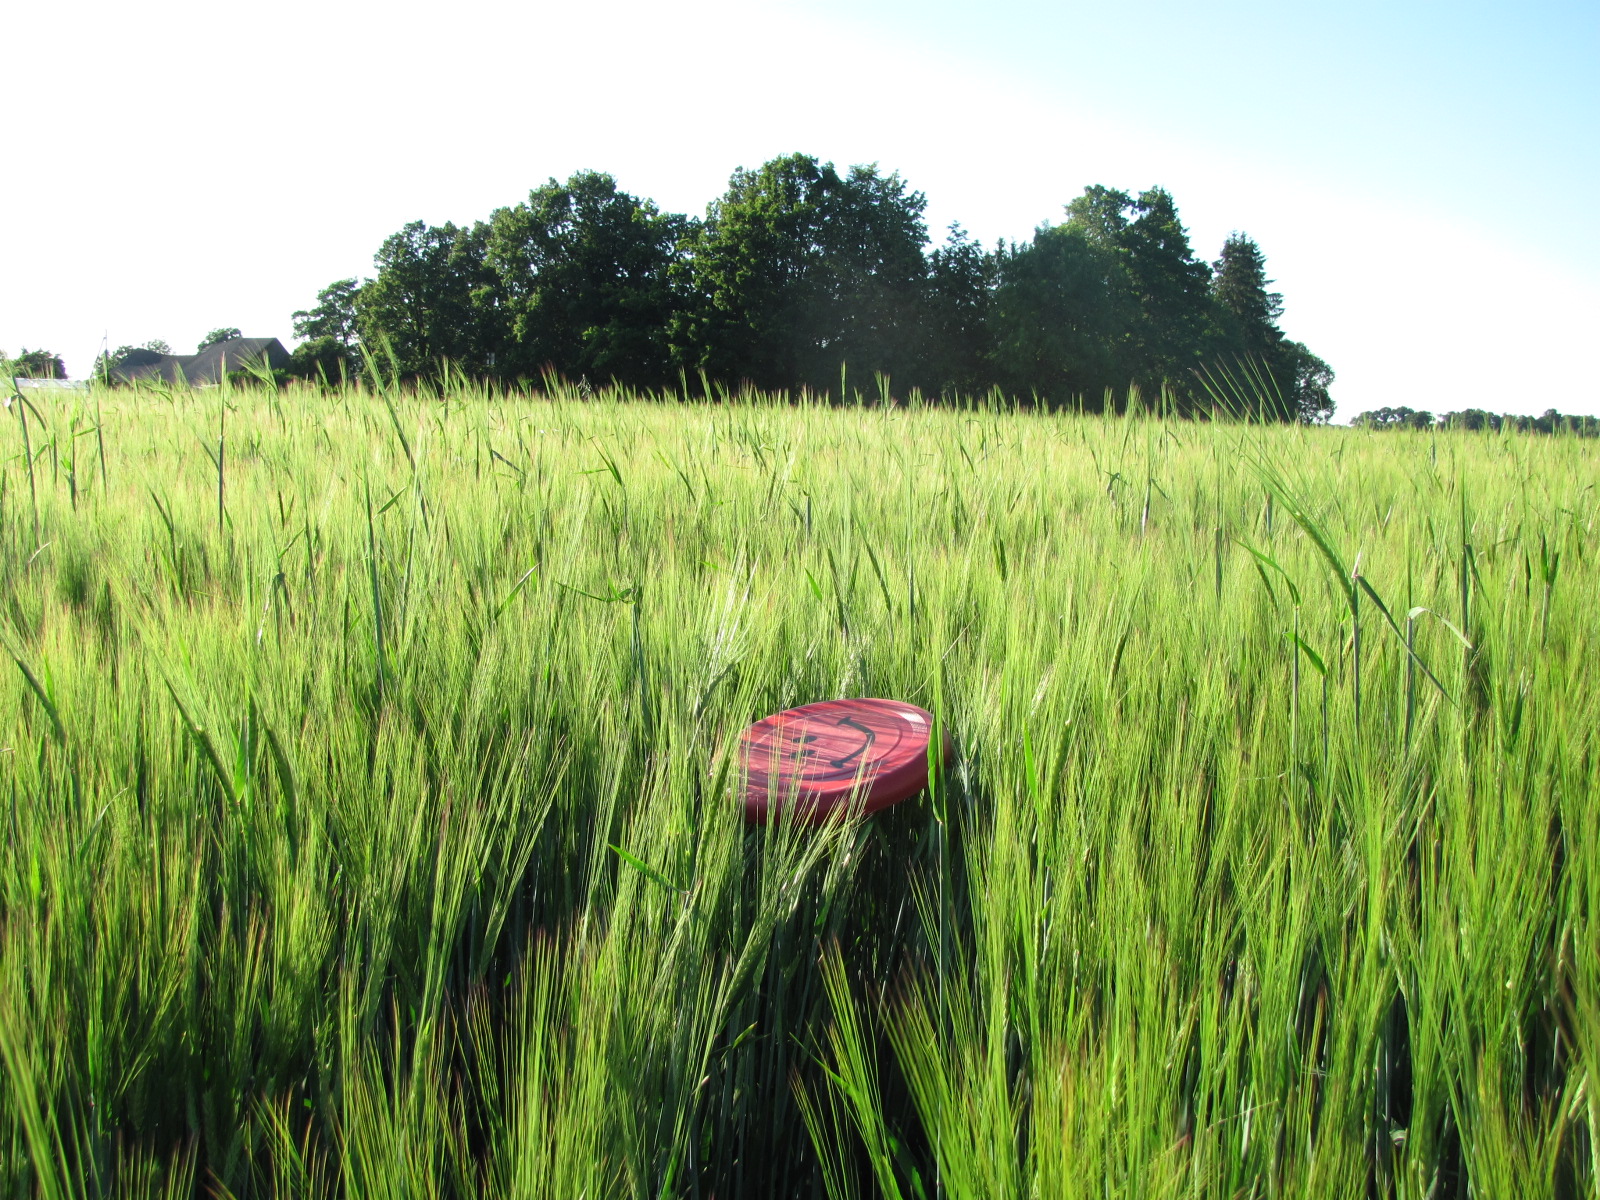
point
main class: Cropland
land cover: Barley
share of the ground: > 75 %
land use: Agriculture (excluding fallow land and kitchen gardens)
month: July
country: LV
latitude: 56.4192
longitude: 23.8453
